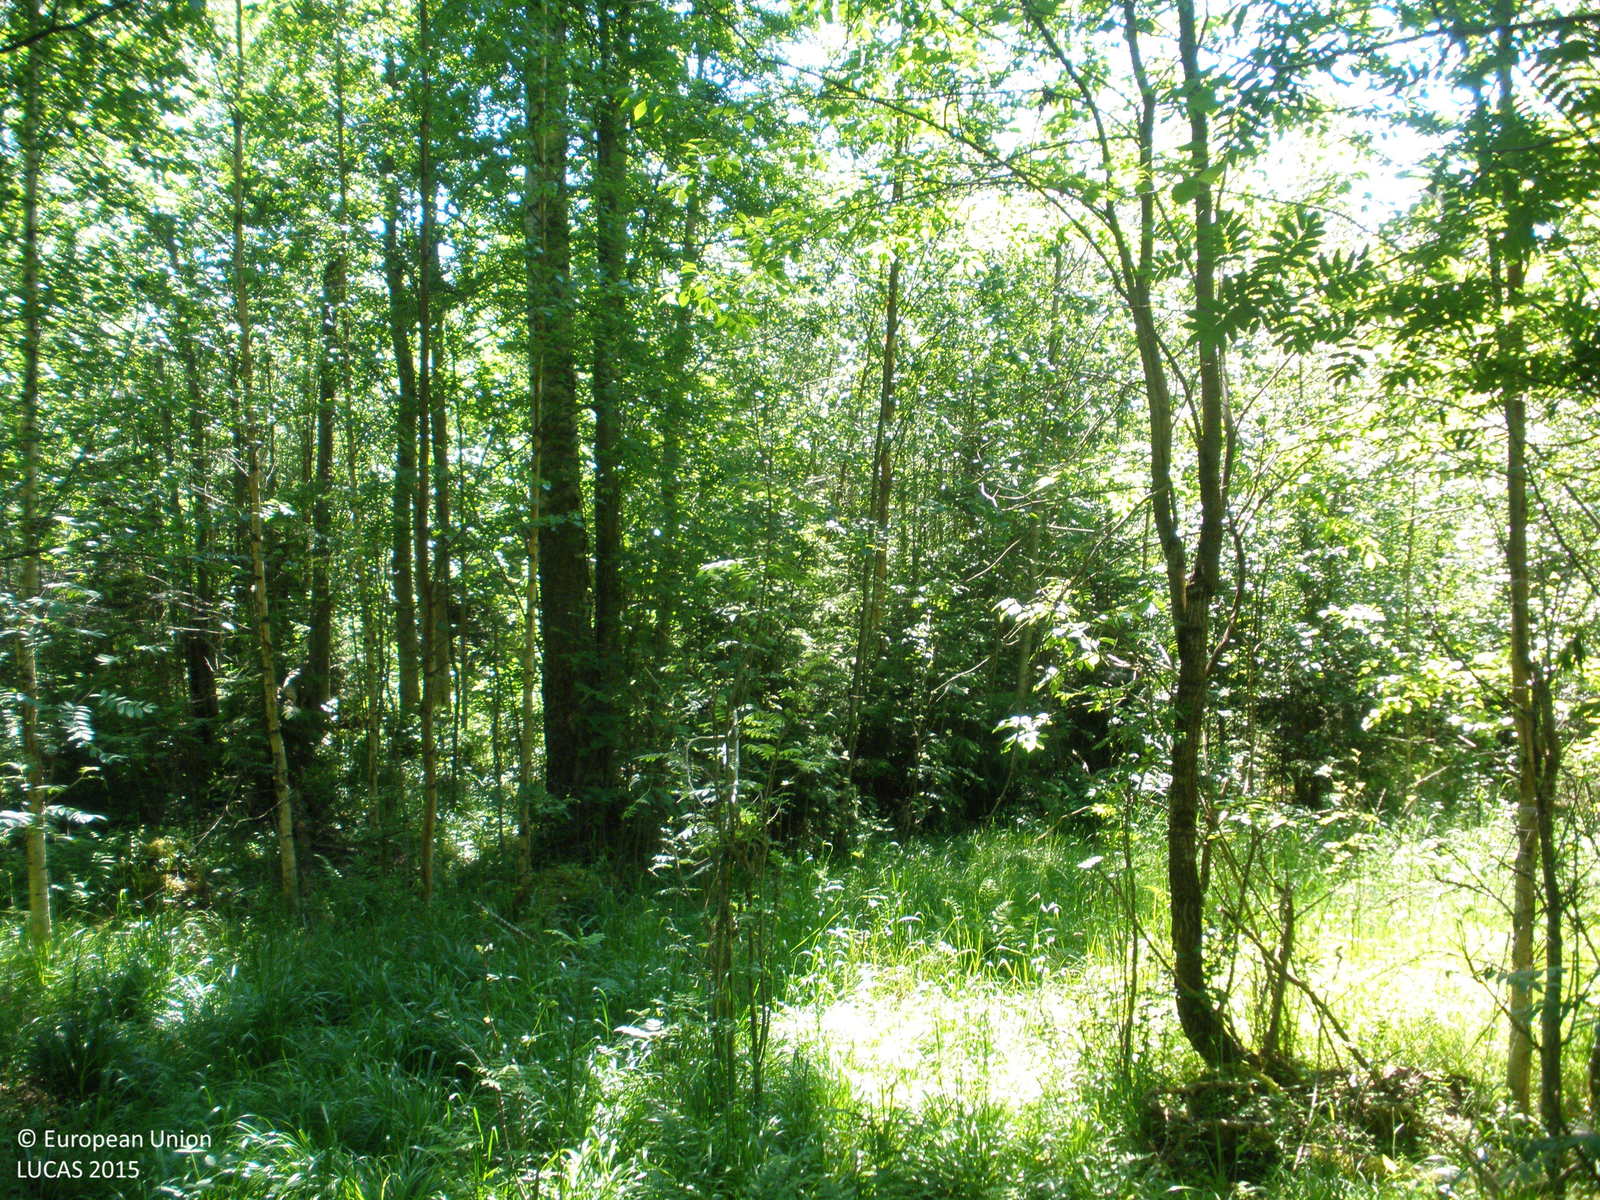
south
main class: Woodland
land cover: Broadleaved woodland
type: non-riverine alder, birch or aspen forest
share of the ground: > 75 %
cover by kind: broadleaved forest trees 85 %, herbaceous plants 15 %
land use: Forestry
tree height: > 5 m
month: July
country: FI
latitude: 61.0401
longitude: 23.7697
